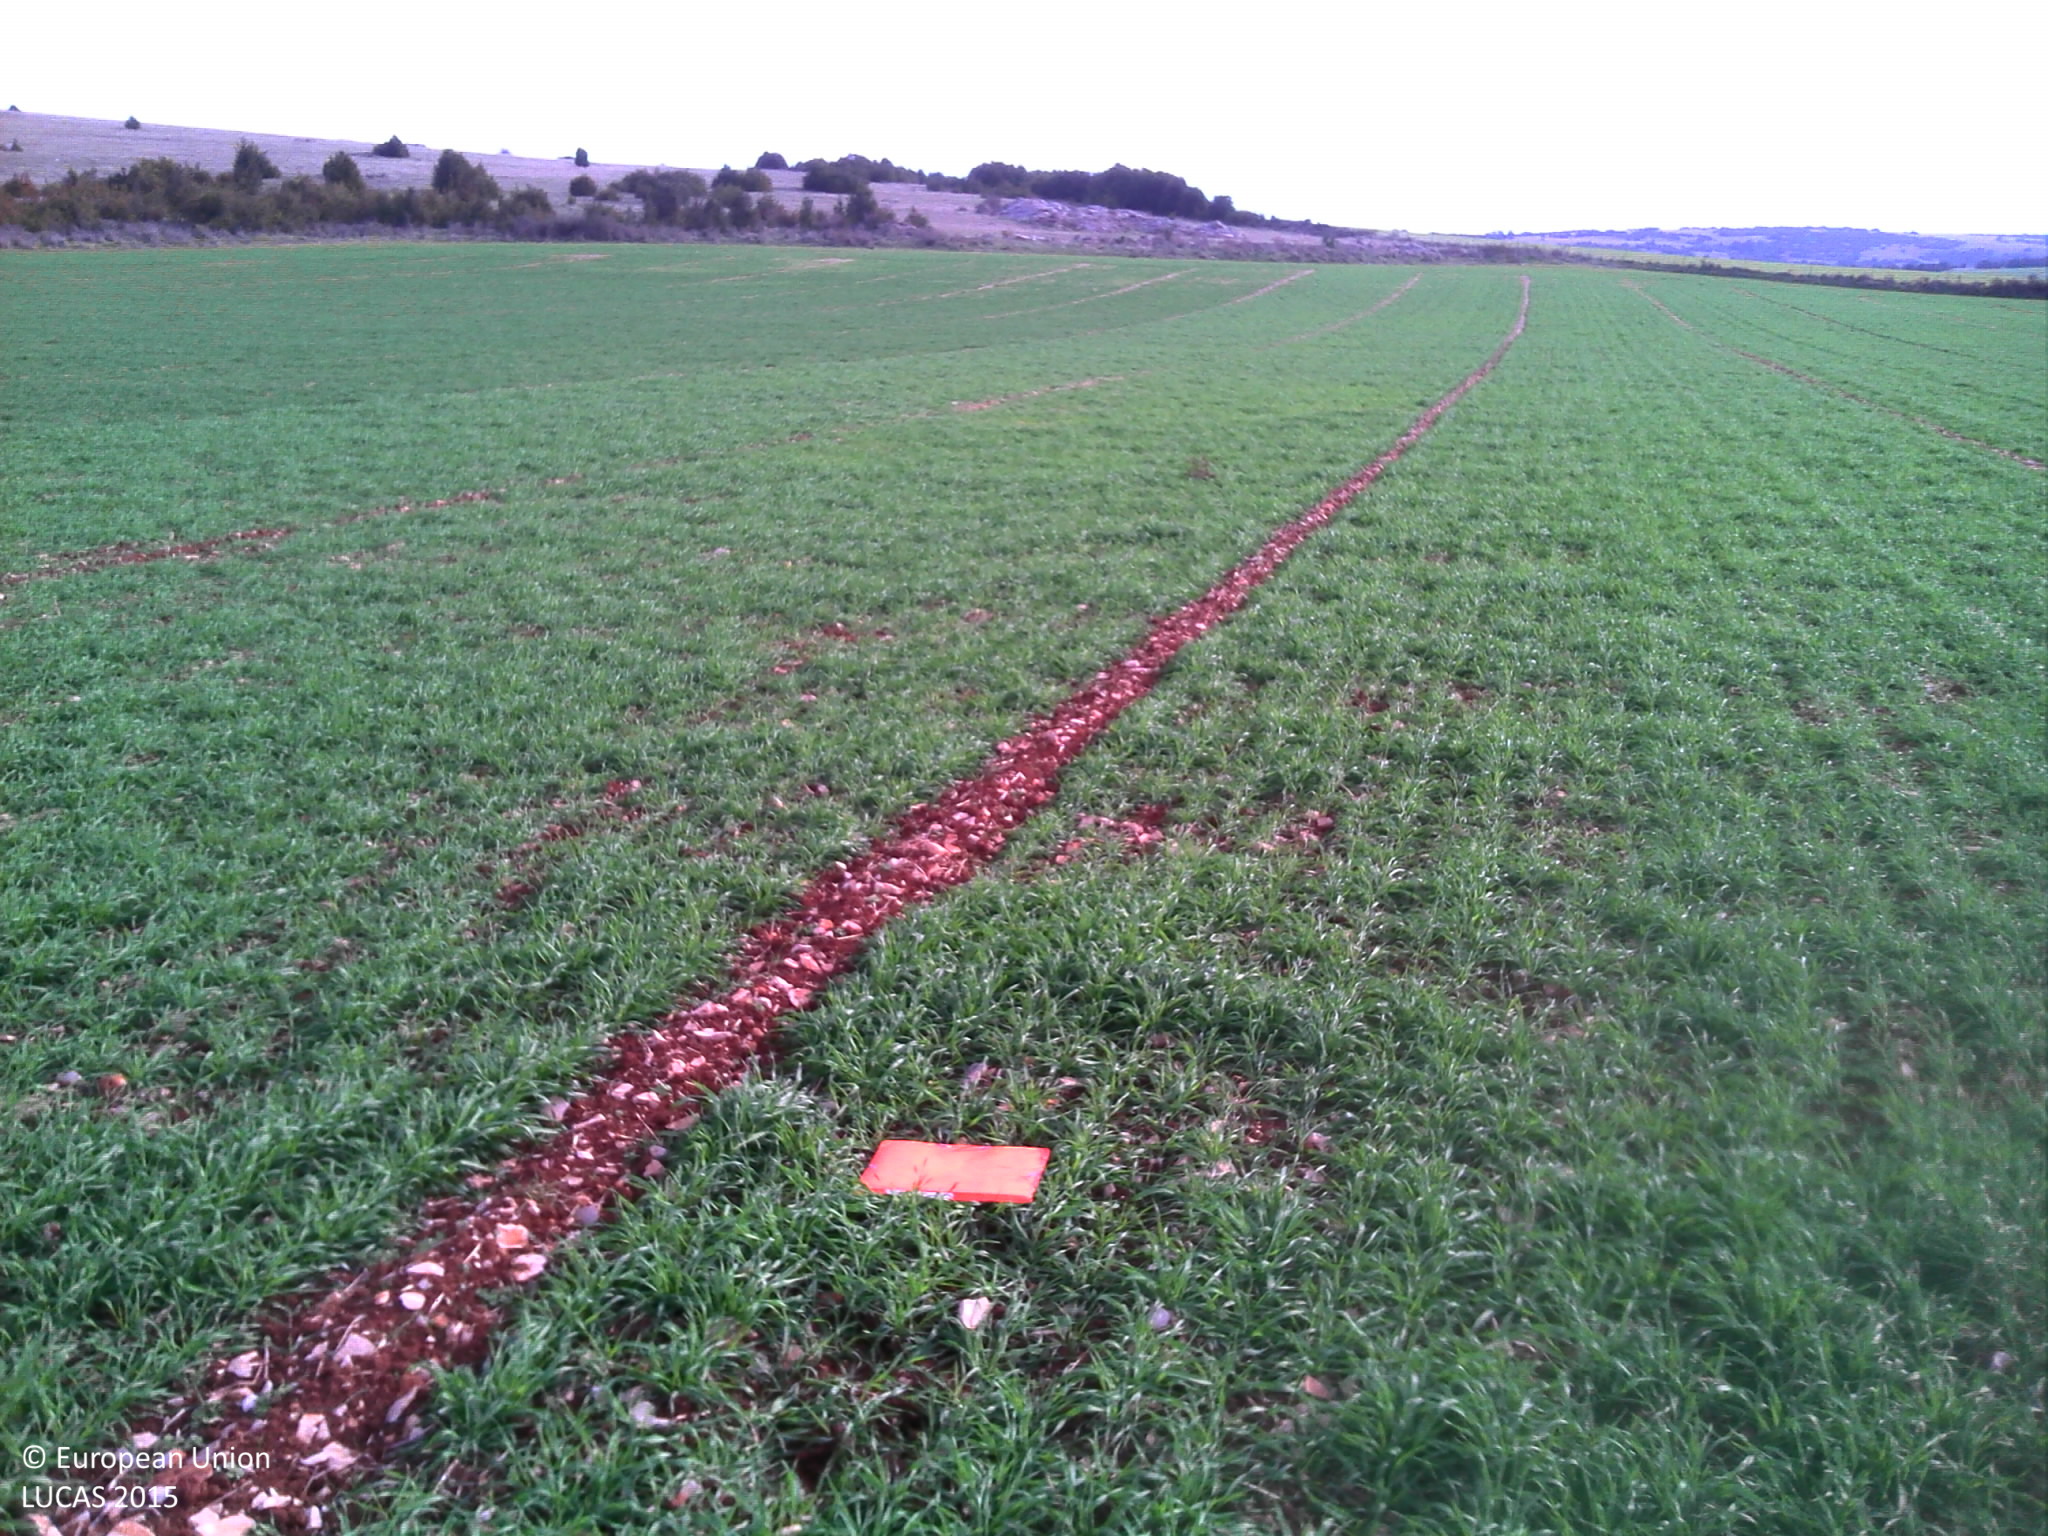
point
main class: Cropland
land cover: Barley
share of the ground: > 75 %
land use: Agriculture (excluding fallow land and kitchen gardens)
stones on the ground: 25 - 50 %
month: November
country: FR
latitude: 44.0487
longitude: 3.1041
